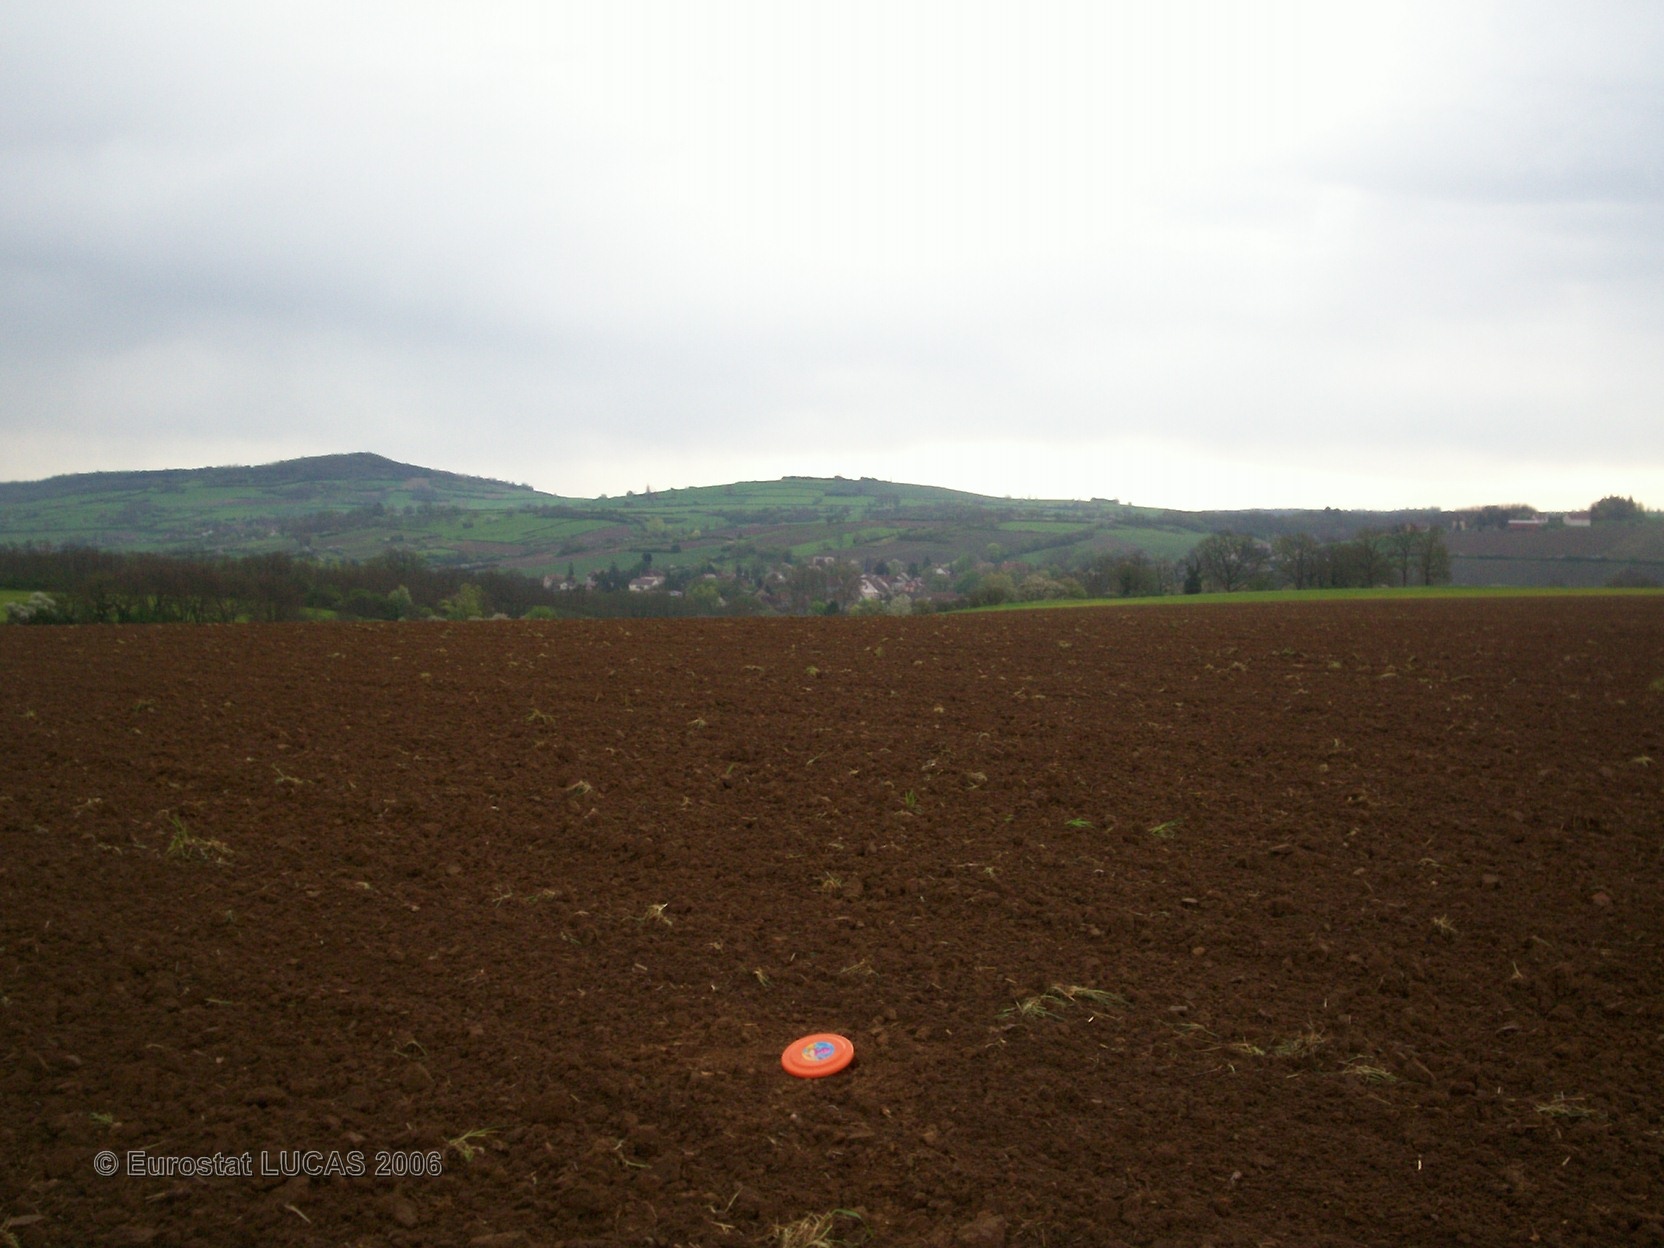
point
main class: Cropland
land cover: Sunflower
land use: Agriculture (excluding fallow land and kitchen gardens)
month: May
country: FR
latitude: 46.8663
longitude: 4.6353
